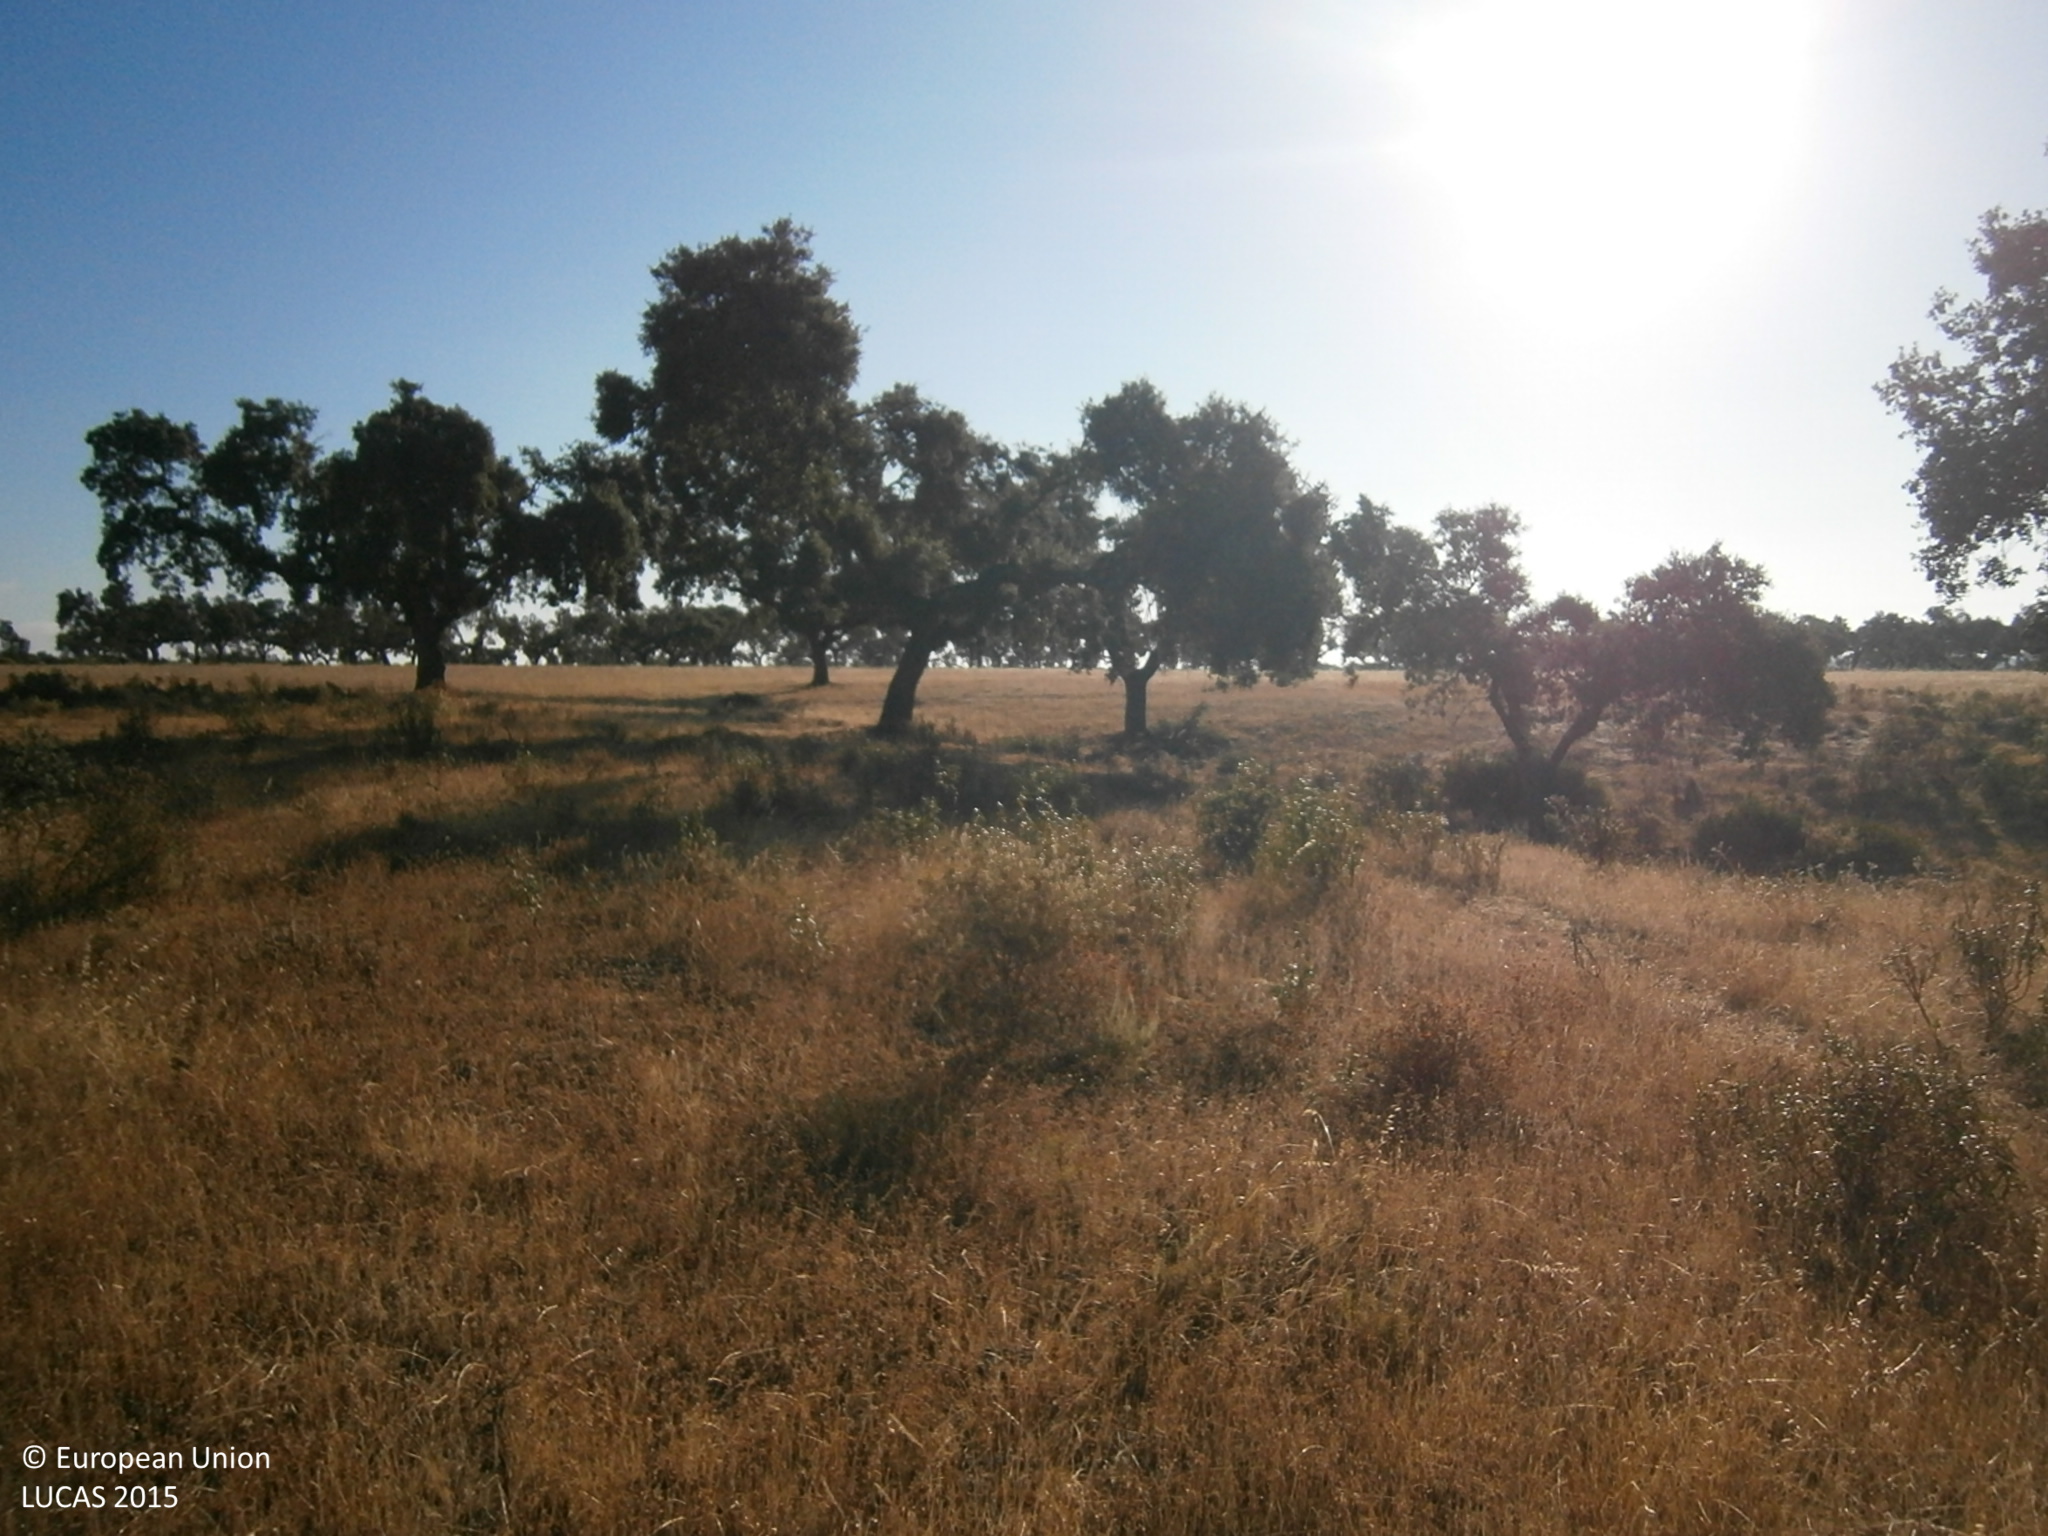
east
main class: Woodland
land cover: Broadleaved woodland
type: broadleaved evergreen forest
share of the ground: > 75 %
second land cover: Shrubland without tree cover
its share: < 10 %
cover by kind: broadleaved forest trees 70 %, herbaceous plants 20 %, shrubs 10 %
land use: Agriculture (excluding fallow land and kitchen gardens)
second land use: Forestry
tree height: > 5 m
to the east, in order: Broadleaved woodland; Shrubland without tree cover; Grassland with sparse tree/shrub cover; Broadleaved woodland; Tracks; Broadleaved woodland
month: July
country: ES
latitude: 38.6565
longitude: -7.2278
